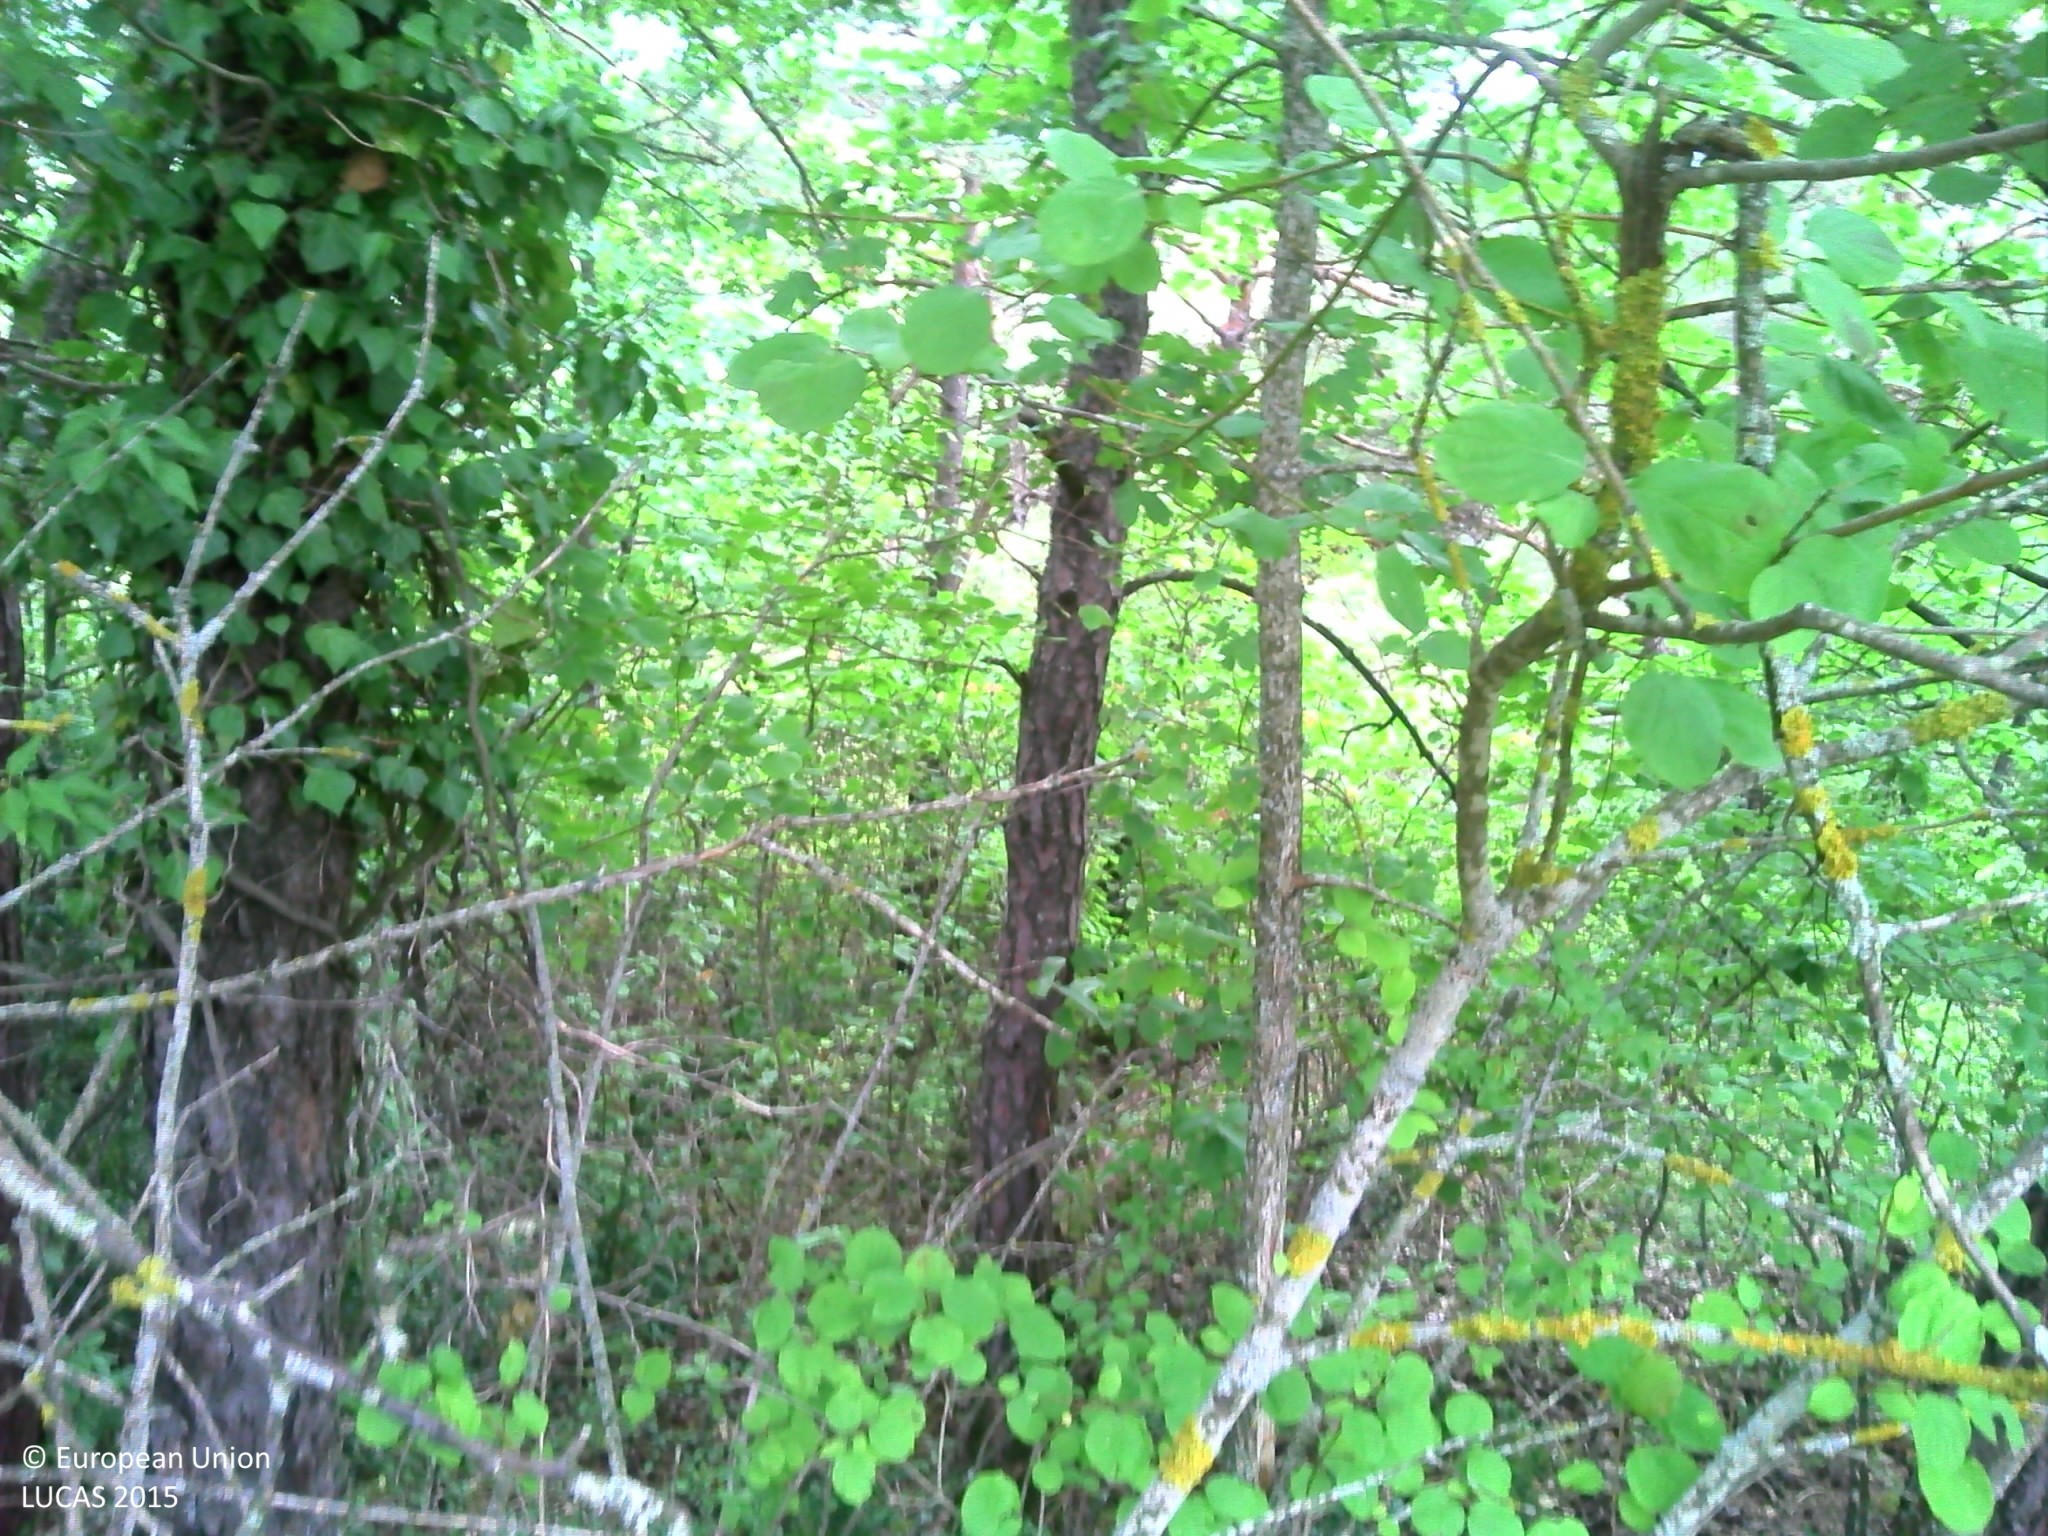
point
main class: Woodland
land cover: Pine dominated coniferous woodland
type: alpine coniferous forest
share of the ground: > 75 %
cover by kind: coniferous forest trees 80 %, broadleaved forest trees 15 %, herbaceous plants 5 %
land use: Forestry
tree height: > 5 m
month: July
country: FR
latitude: 44.7659
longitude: 5.6727
